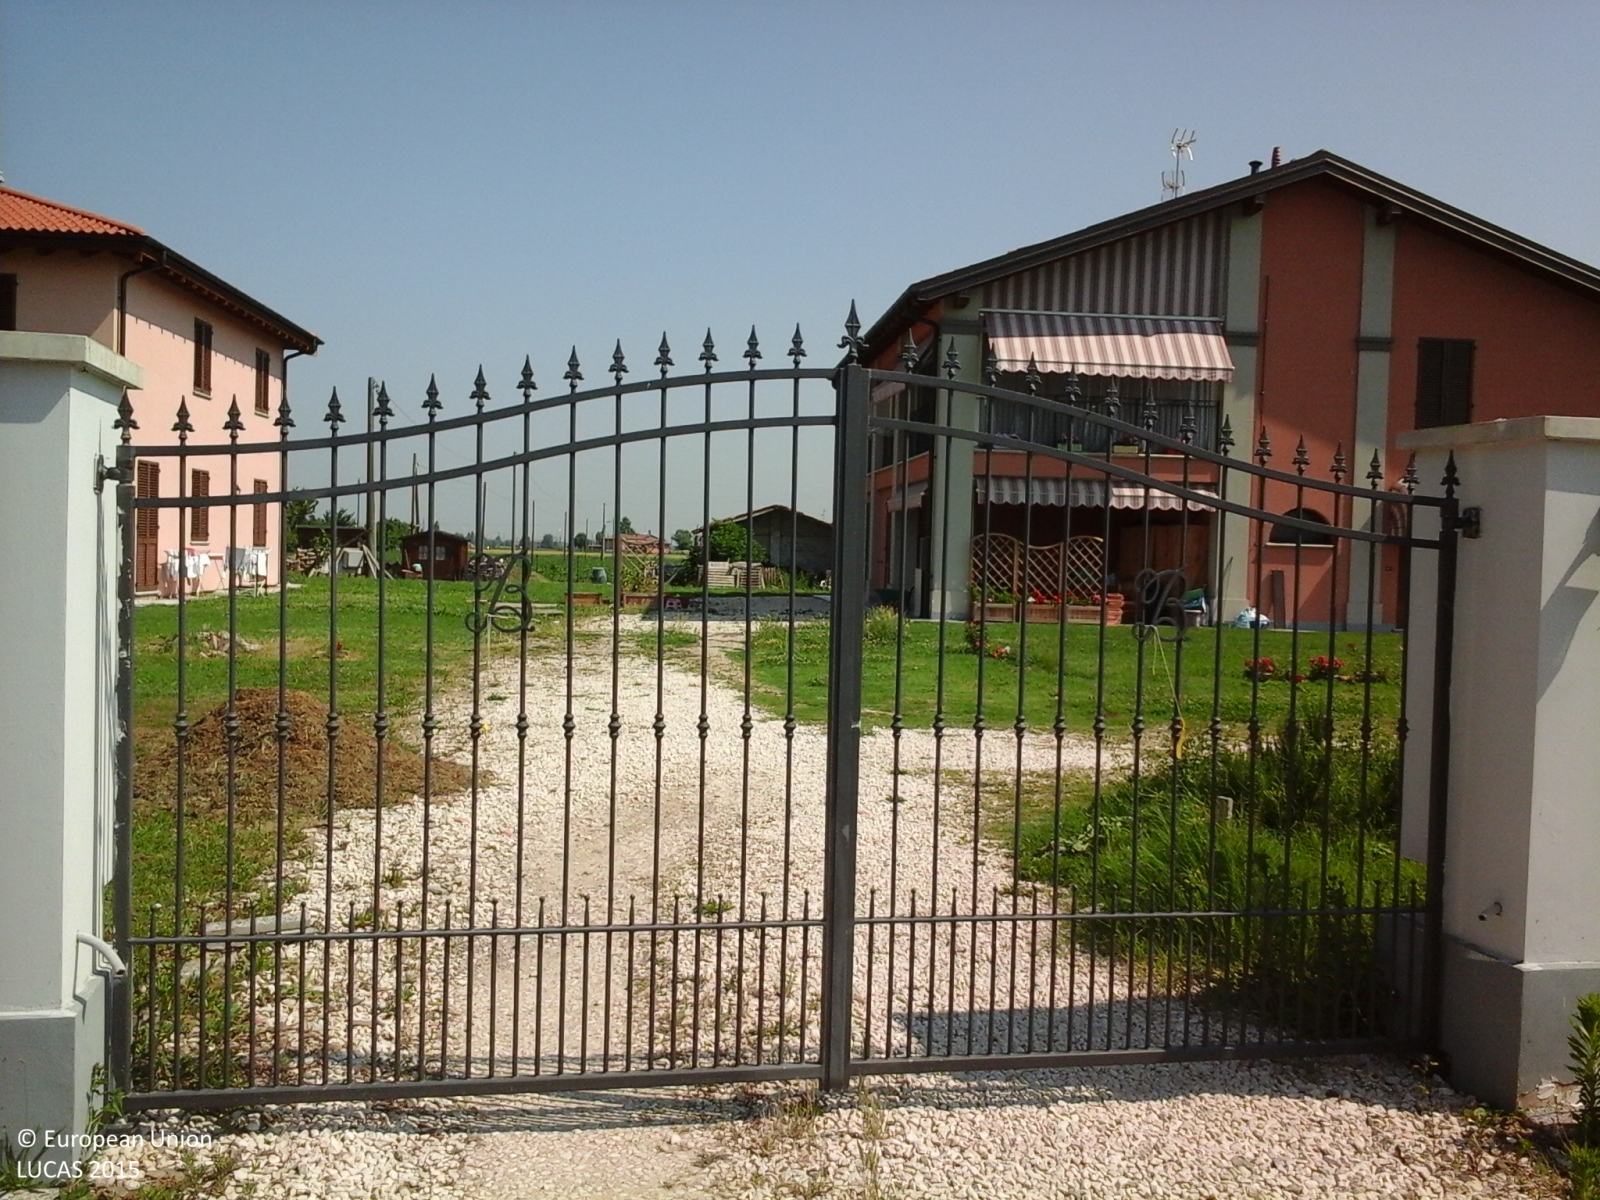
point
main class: Grassland
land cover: Grassland without tree/shrub cover
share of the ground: > 75 %
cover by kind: herbaceous plants 100 %
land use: Residential
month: June
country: IT
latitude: 44.5601
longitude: 11.1935
